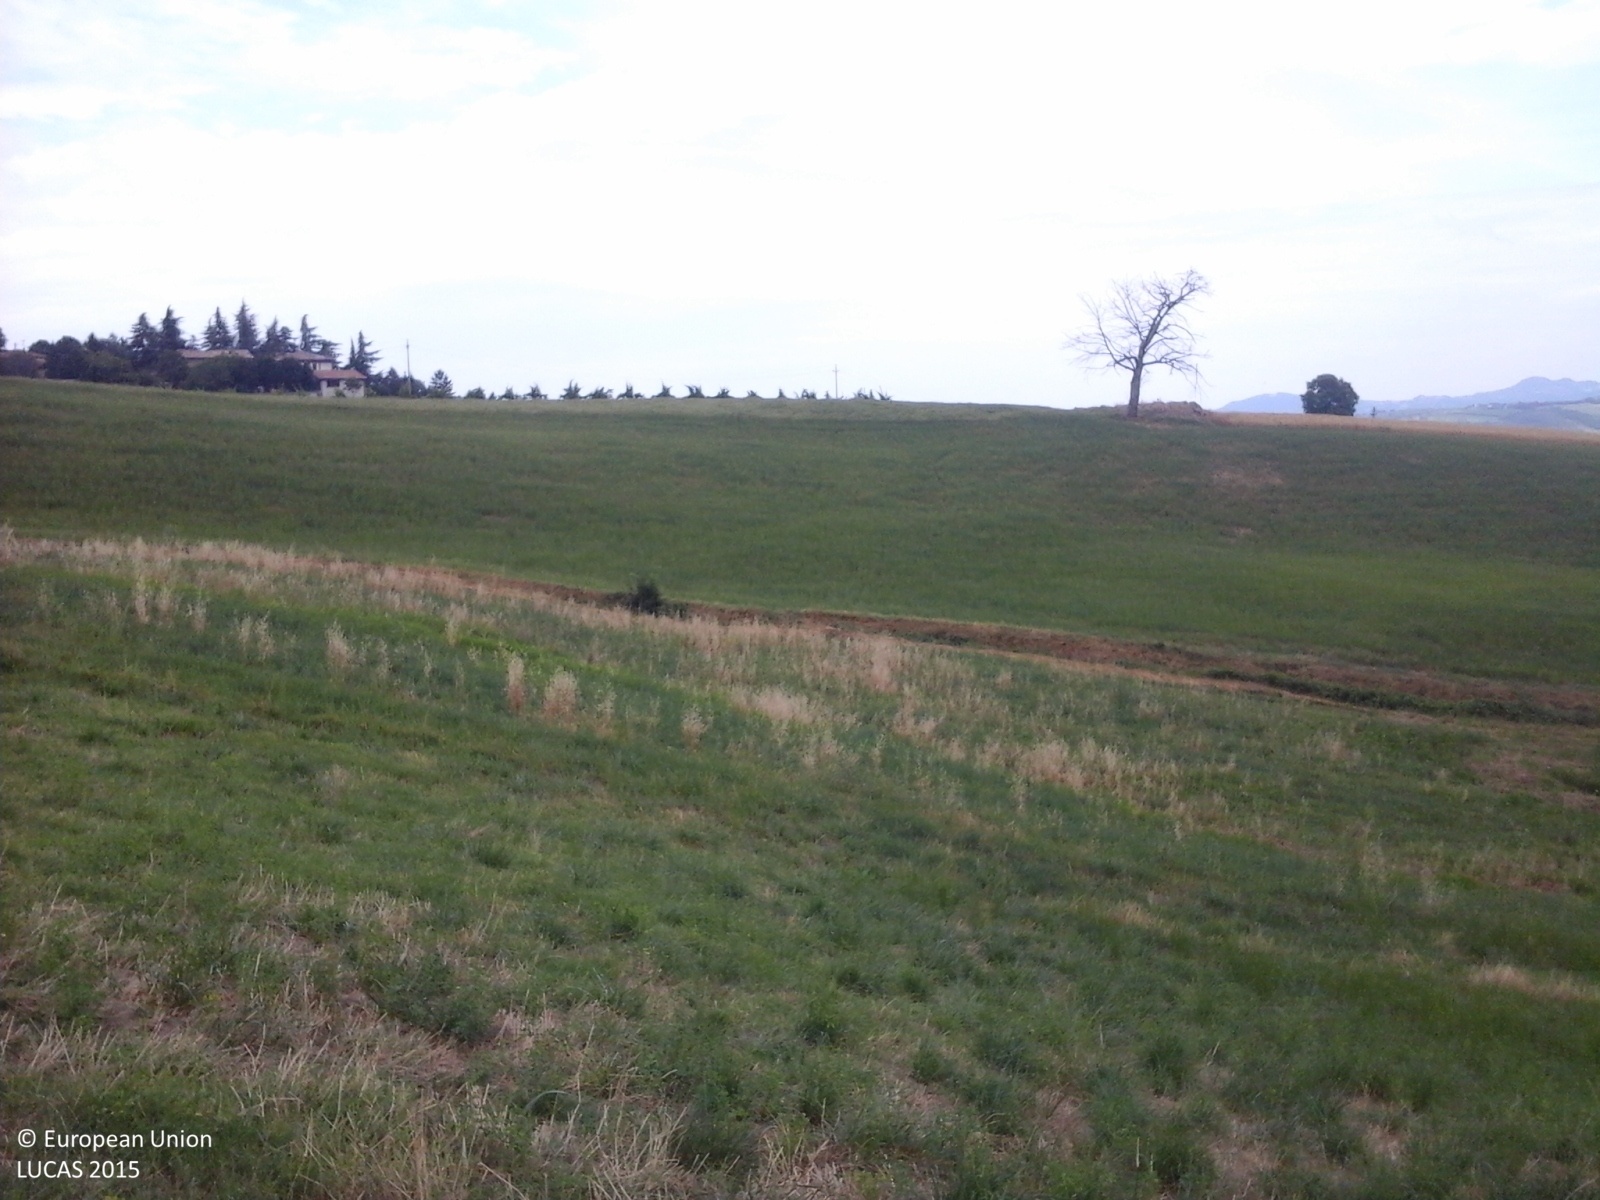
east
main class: Grassland
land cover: Grassland without tree/shrub cover
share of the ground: > 75 %
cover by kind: herbaceous plants 100 %
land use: Agriculture (excluding fallow land and kitchen gardens)
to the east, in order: Grassland without tree/shrub cover; Ditches and canals; Grass margins; Temporary grasslands; Common wheat
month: June
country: IT
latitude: 44.5666
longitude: 10.2890
